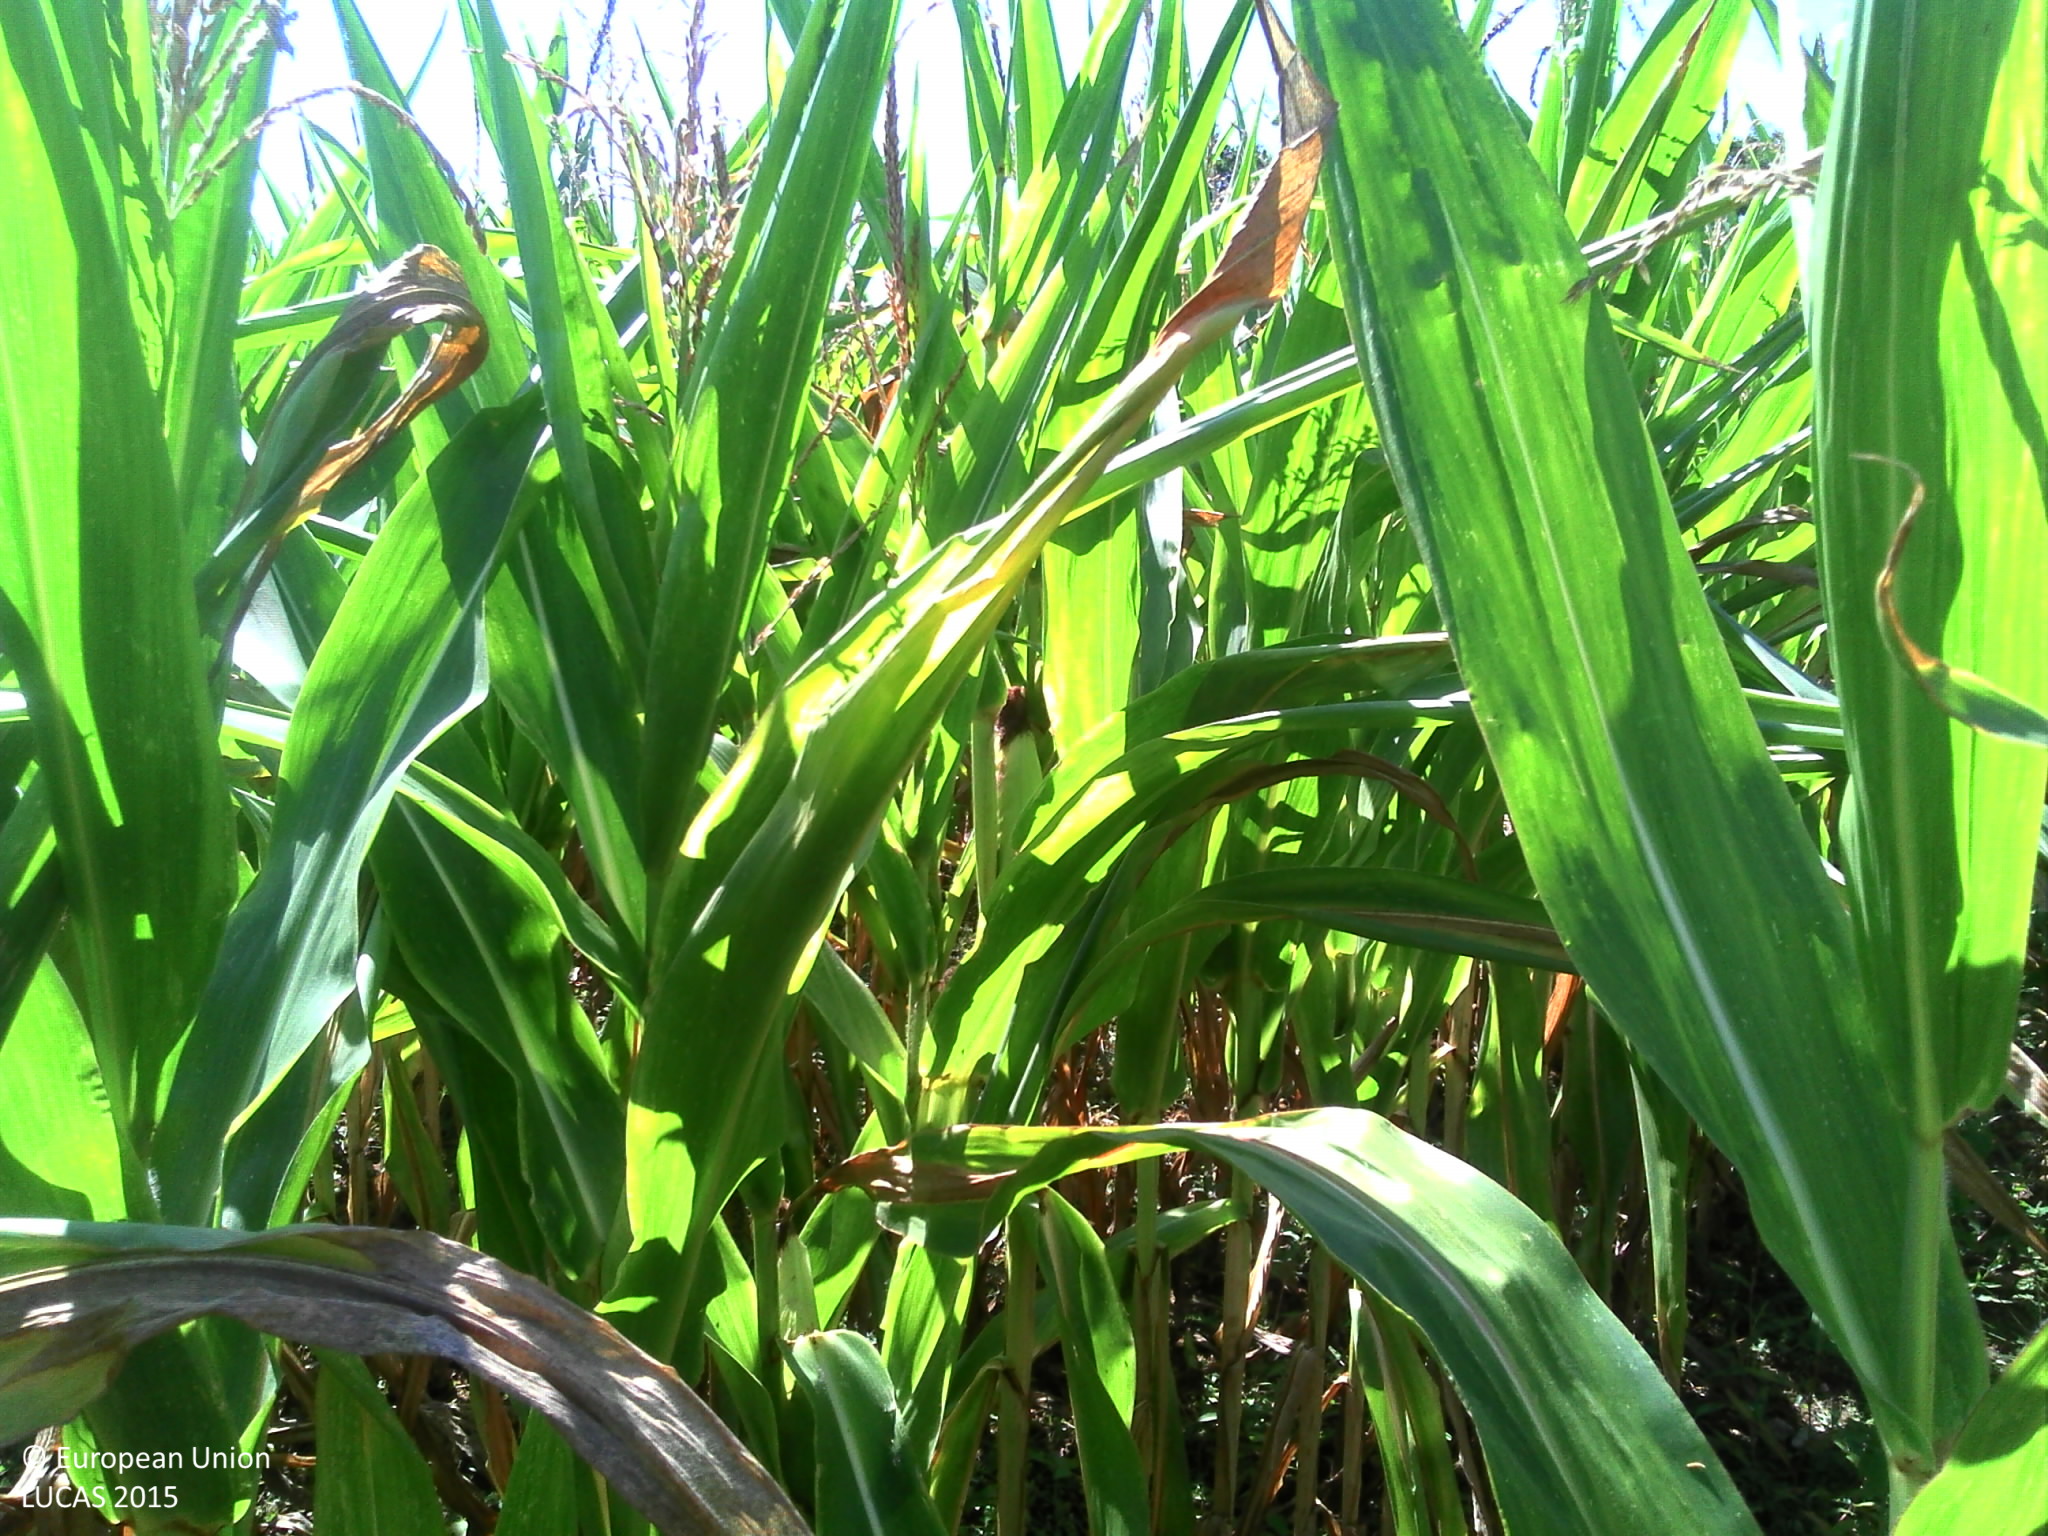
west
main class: Cropland
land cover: Maize
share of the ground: > 75 %
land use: Agriculture (excluding fallow land and kitchen gardens)
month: August
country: FR
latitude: 46.1828
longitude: 0.9315
